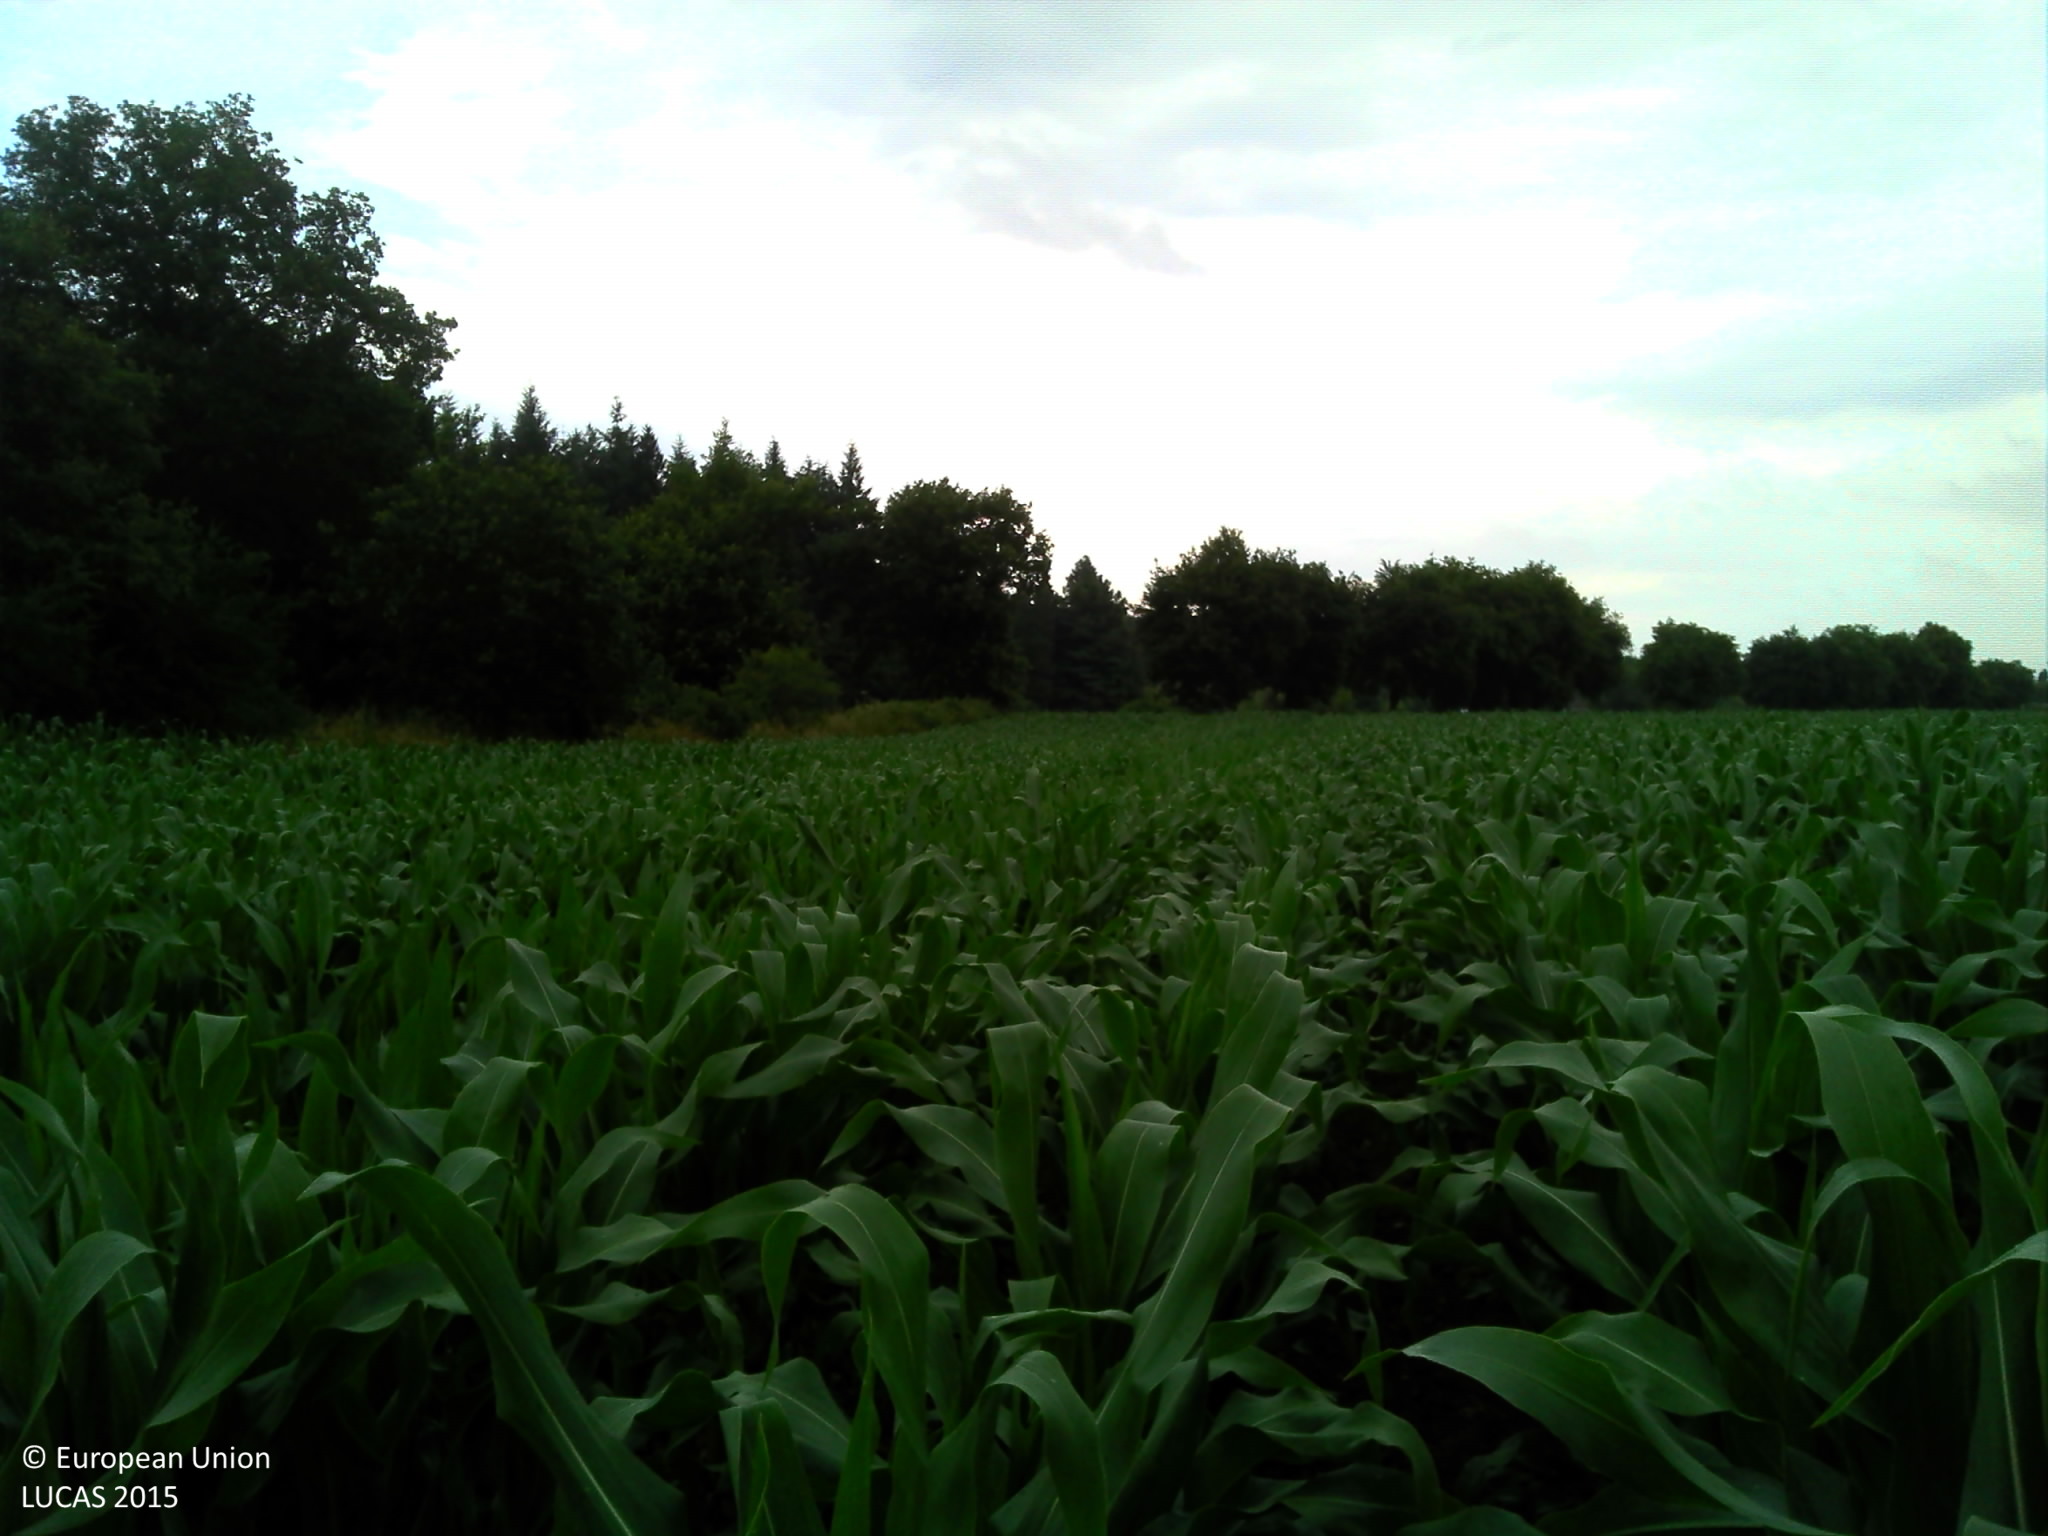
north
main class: Cropland
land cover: Maize
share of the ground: > 75 %
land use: Agriculture (excluding fallow land and kitchen gardens)
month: July
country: FR
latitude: 47.9025
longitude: -1.4009
